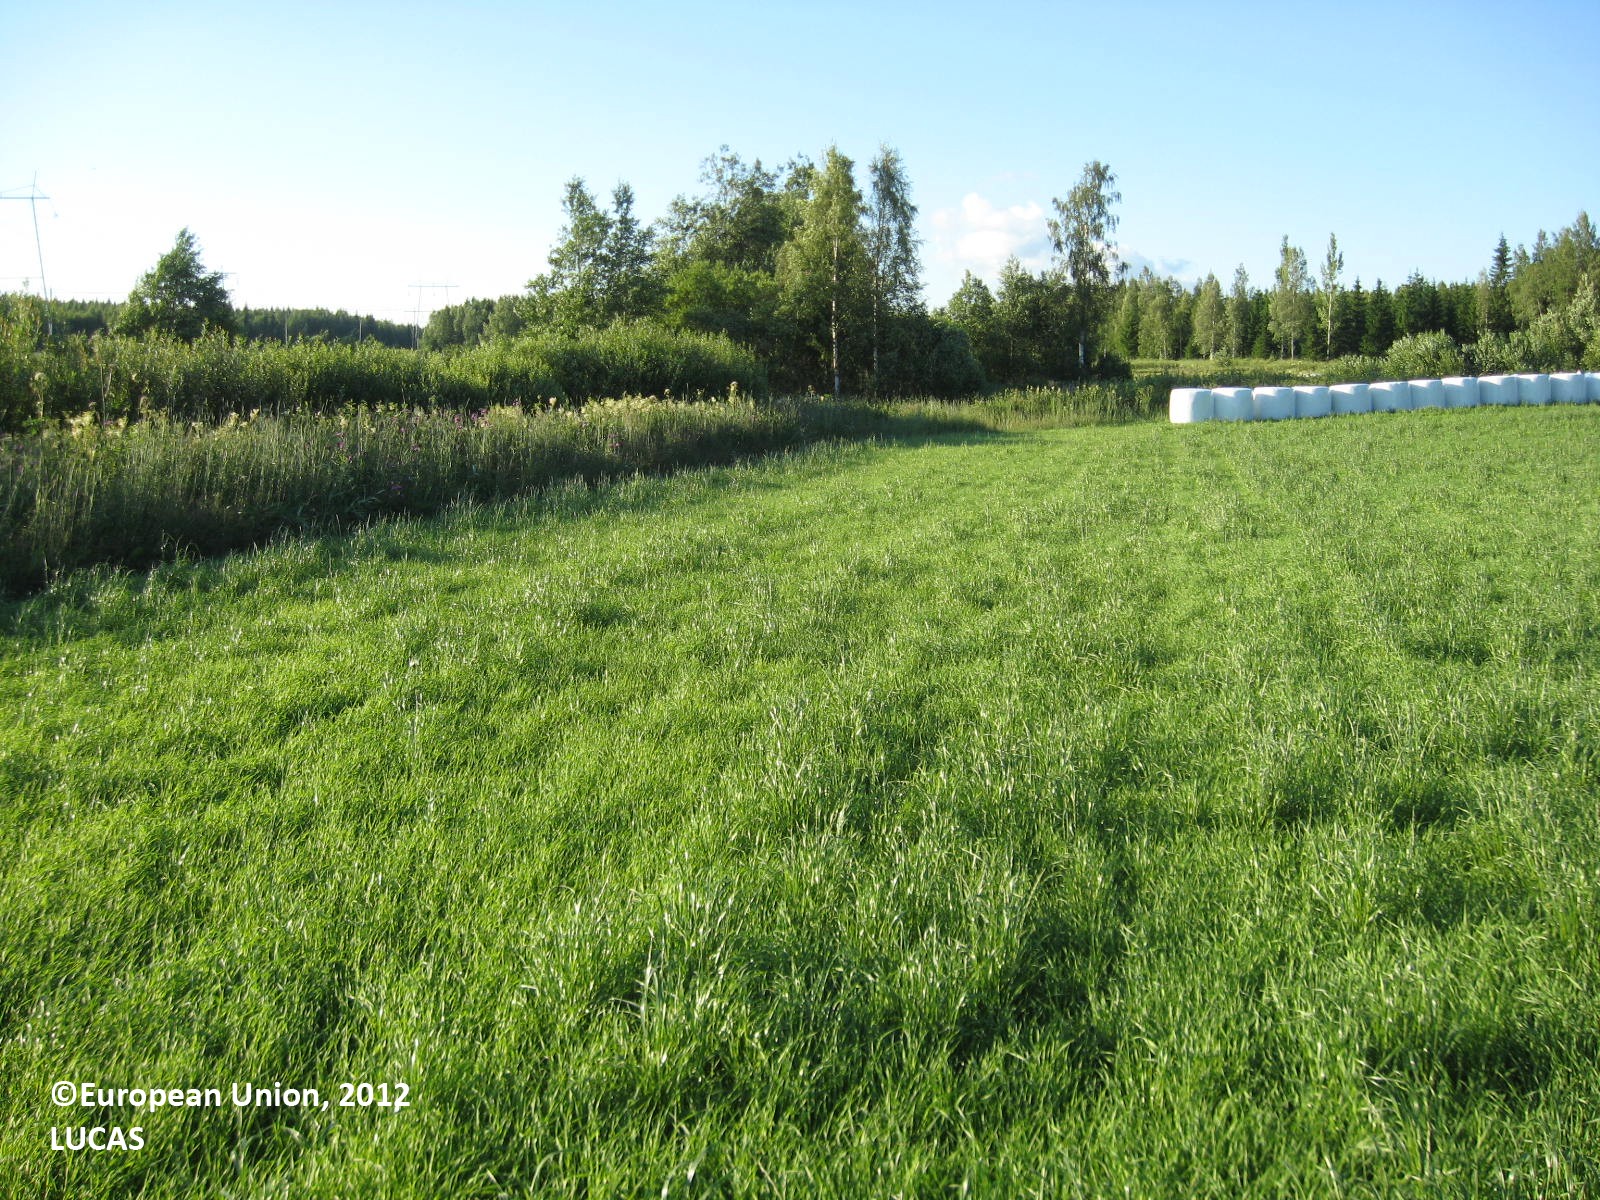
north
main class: Cropland
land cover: Temporary grasslands
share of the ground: > 75 %
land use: Agriculture (excluding fallow land and kitchen gardens)
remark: Harvested field
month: July
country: FI
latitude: 62.3795
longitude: 21.6271
